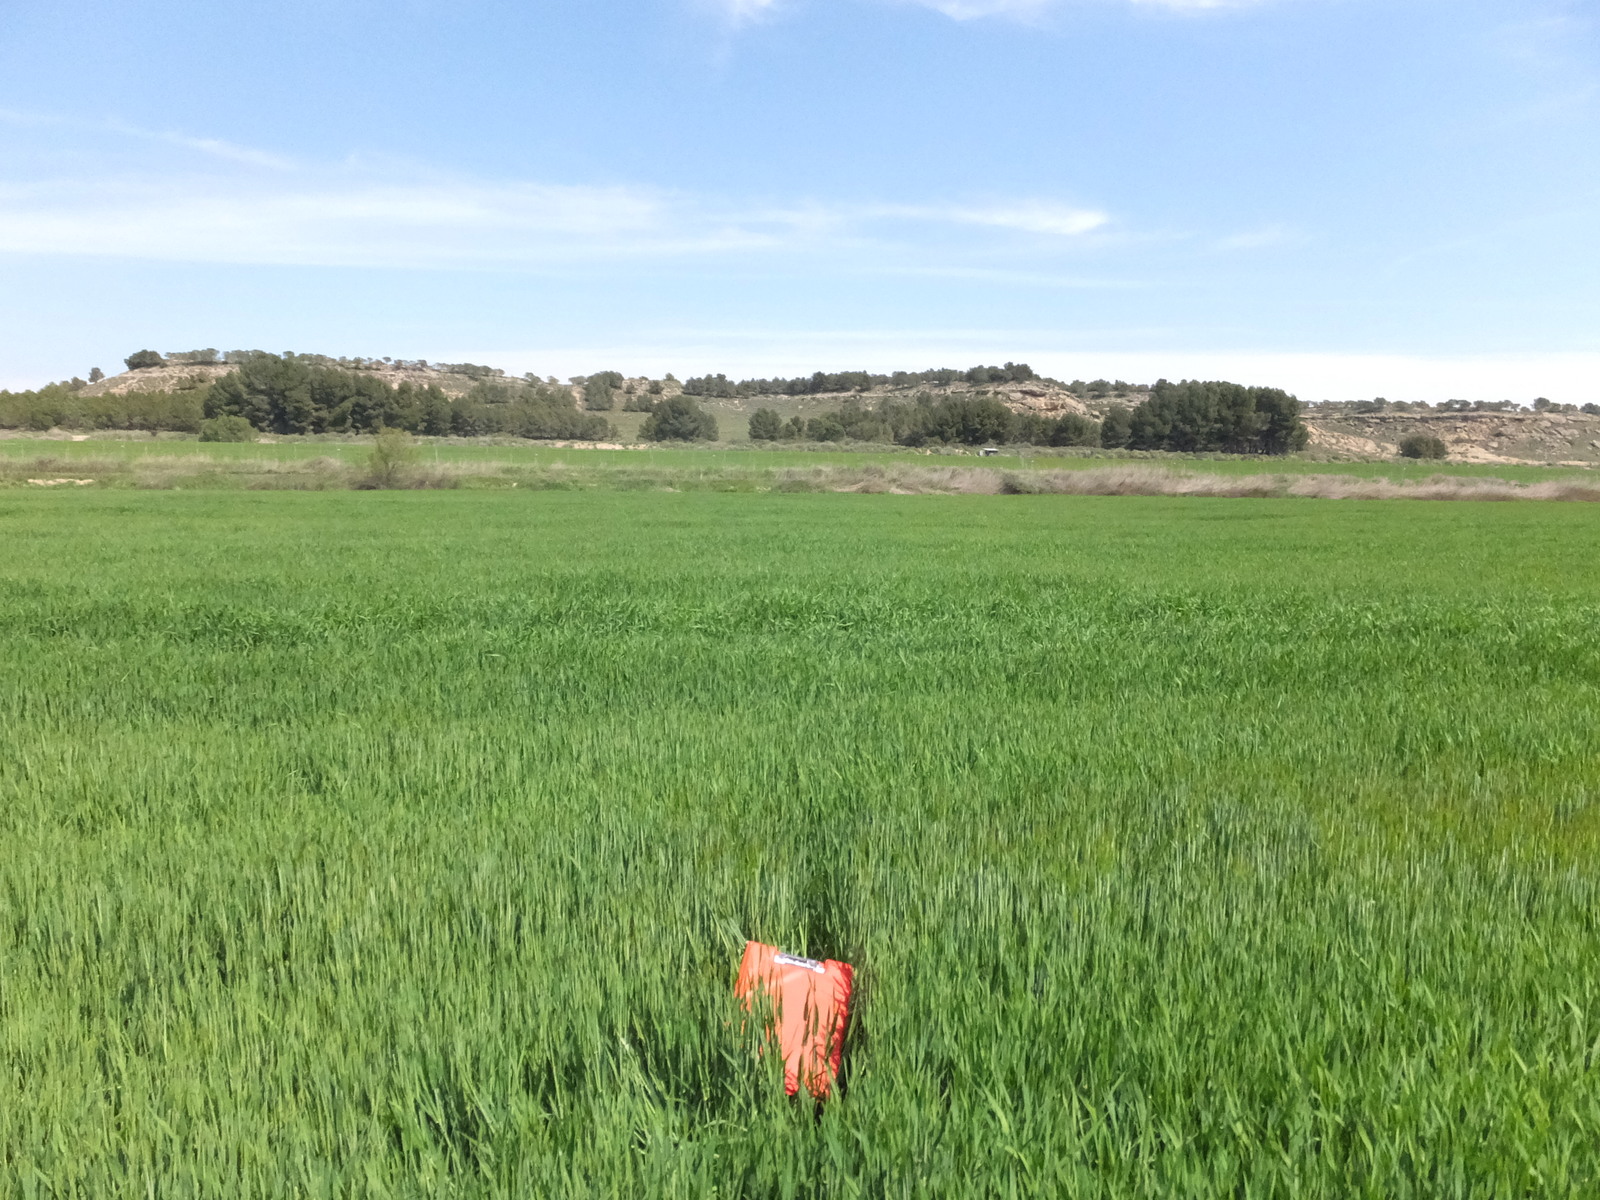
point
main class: Cropland
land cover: Durum wheat
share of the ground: > 75 %
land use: Agriculture (excluding fallow land and kitchen gardens)
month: April
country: ES
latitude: 41.7732
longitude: -0.2077
